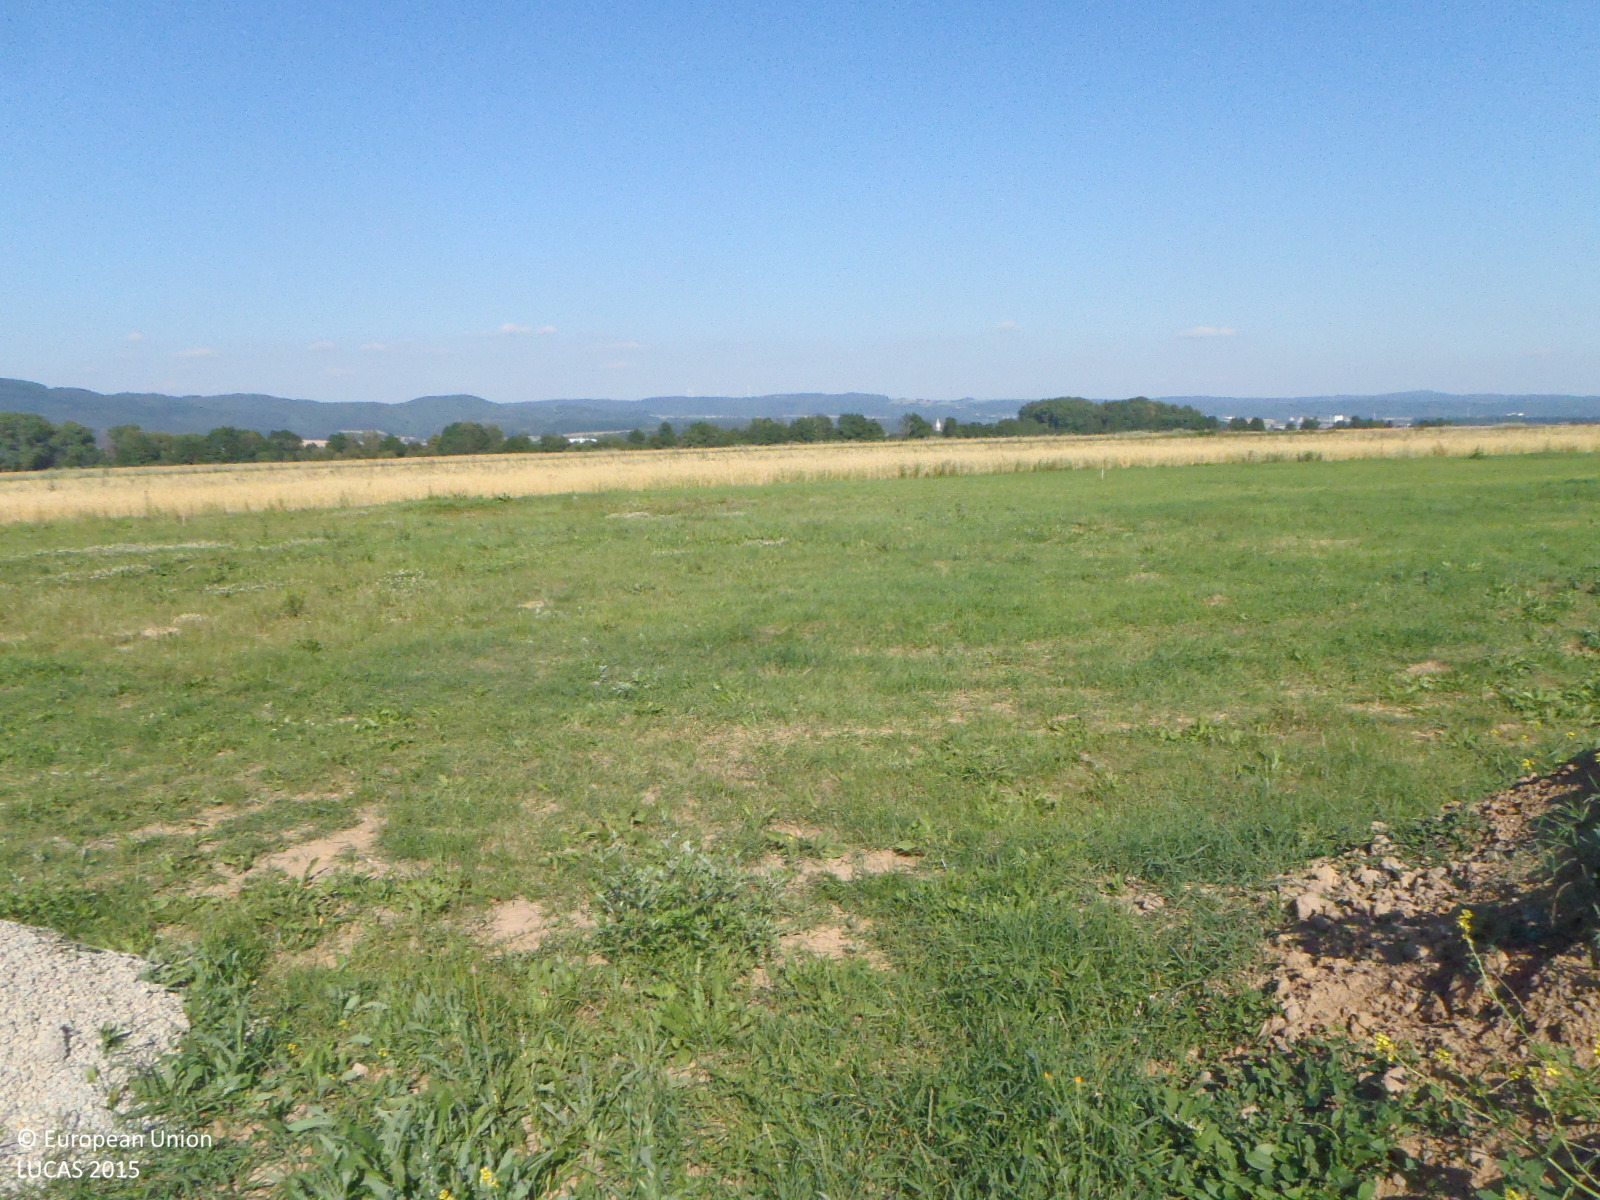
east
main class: Grassland
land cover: Spontaneously vegetated surfaces
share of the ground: > 75 %
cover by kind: herbaceous plants 85 %, unconsolidated bare surface 15 %
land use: Construction
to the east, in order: Spontaneously vegetated surfaces; Grassland without tree/shrub cover; Common wheat; Grass margins; Barley; Potatoes; Other root crops; Potatoes; Lucerne; Barley; Grass margins; Tracks; Barley
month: July
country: CZ
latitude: 49.7587
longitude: 17.1873
